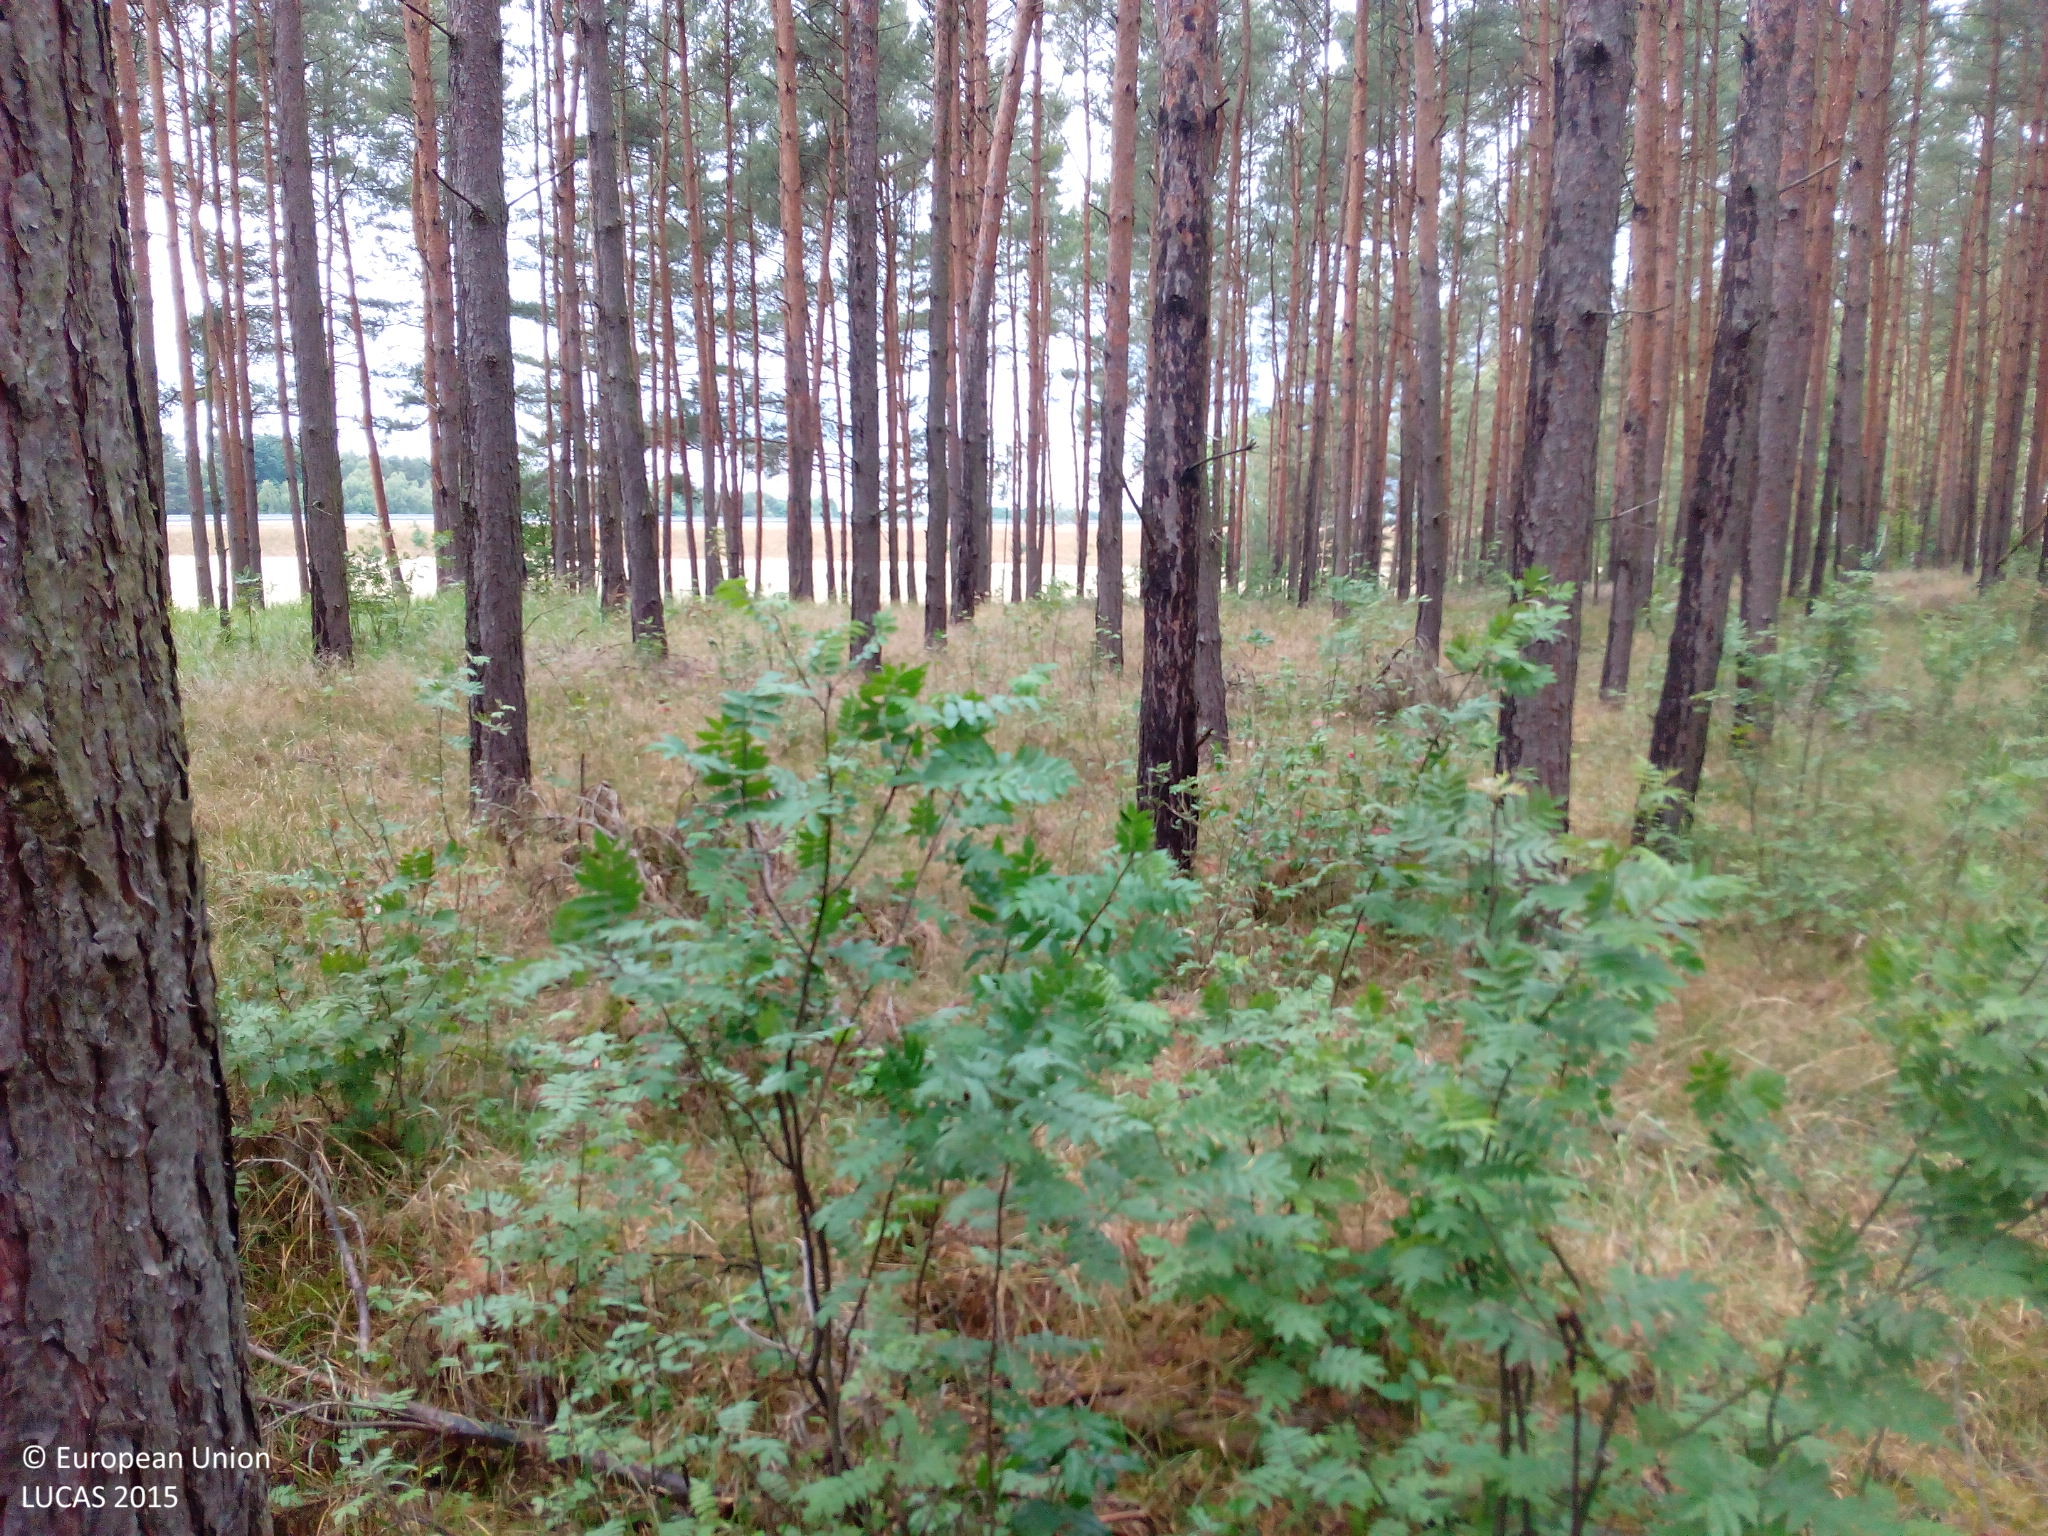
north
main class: Woodland
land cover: Pine dominated coniferous woodland
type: hemiboreal forest and nemoral coniferous forest and mixed broadleaved-coniferous forest
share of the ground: 50 - 75 %
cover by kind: coniferous forest trees 65 %, herbaceous plants 15 %, broadleaved forest trees 10 %, lichens and mosses 10 %
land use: Forestry
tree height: > 5 m
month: June
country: DE
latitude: 52.4084
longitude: 12.3369
